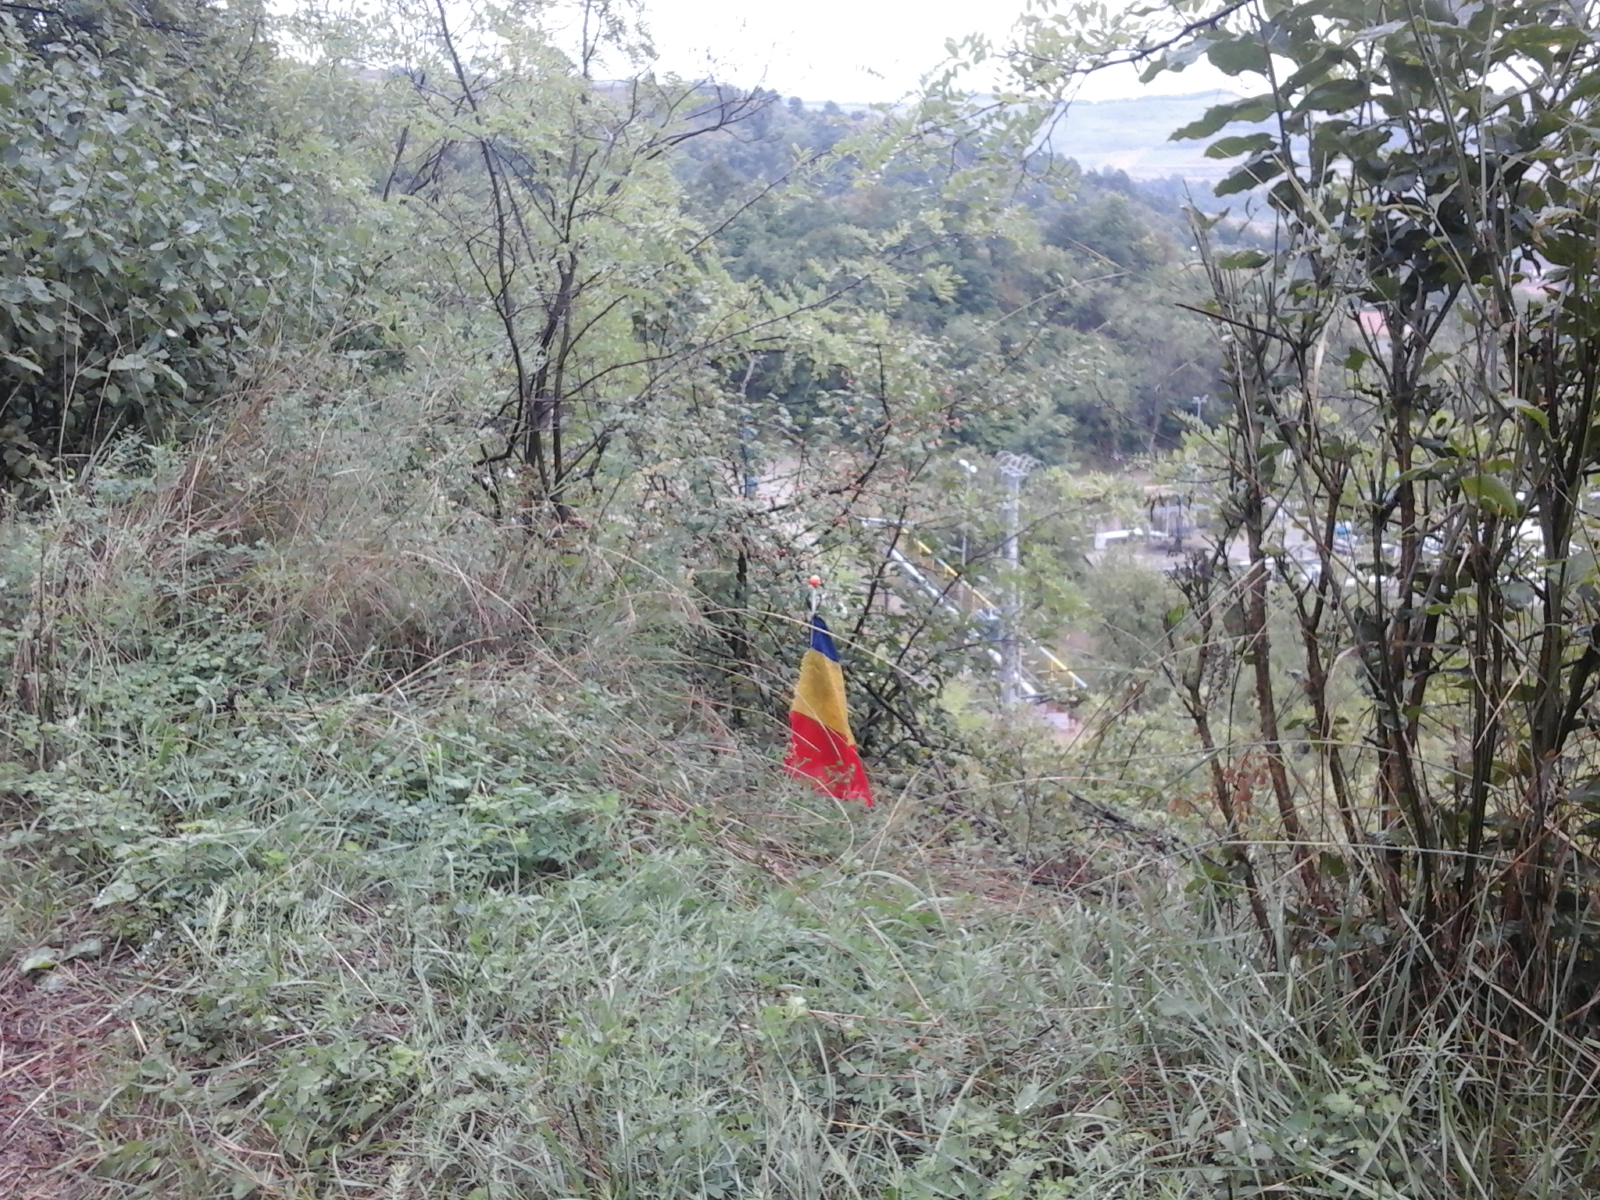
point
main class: Shrubland
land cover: Shrubland with sparse tree cover
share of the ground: > 75 %
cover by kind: shrubs 95 %, broadleaved forest trees 5 %
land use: Fallow land
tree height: < 5 m
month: September
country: RO
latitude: 47.2636
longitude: 22.5725
